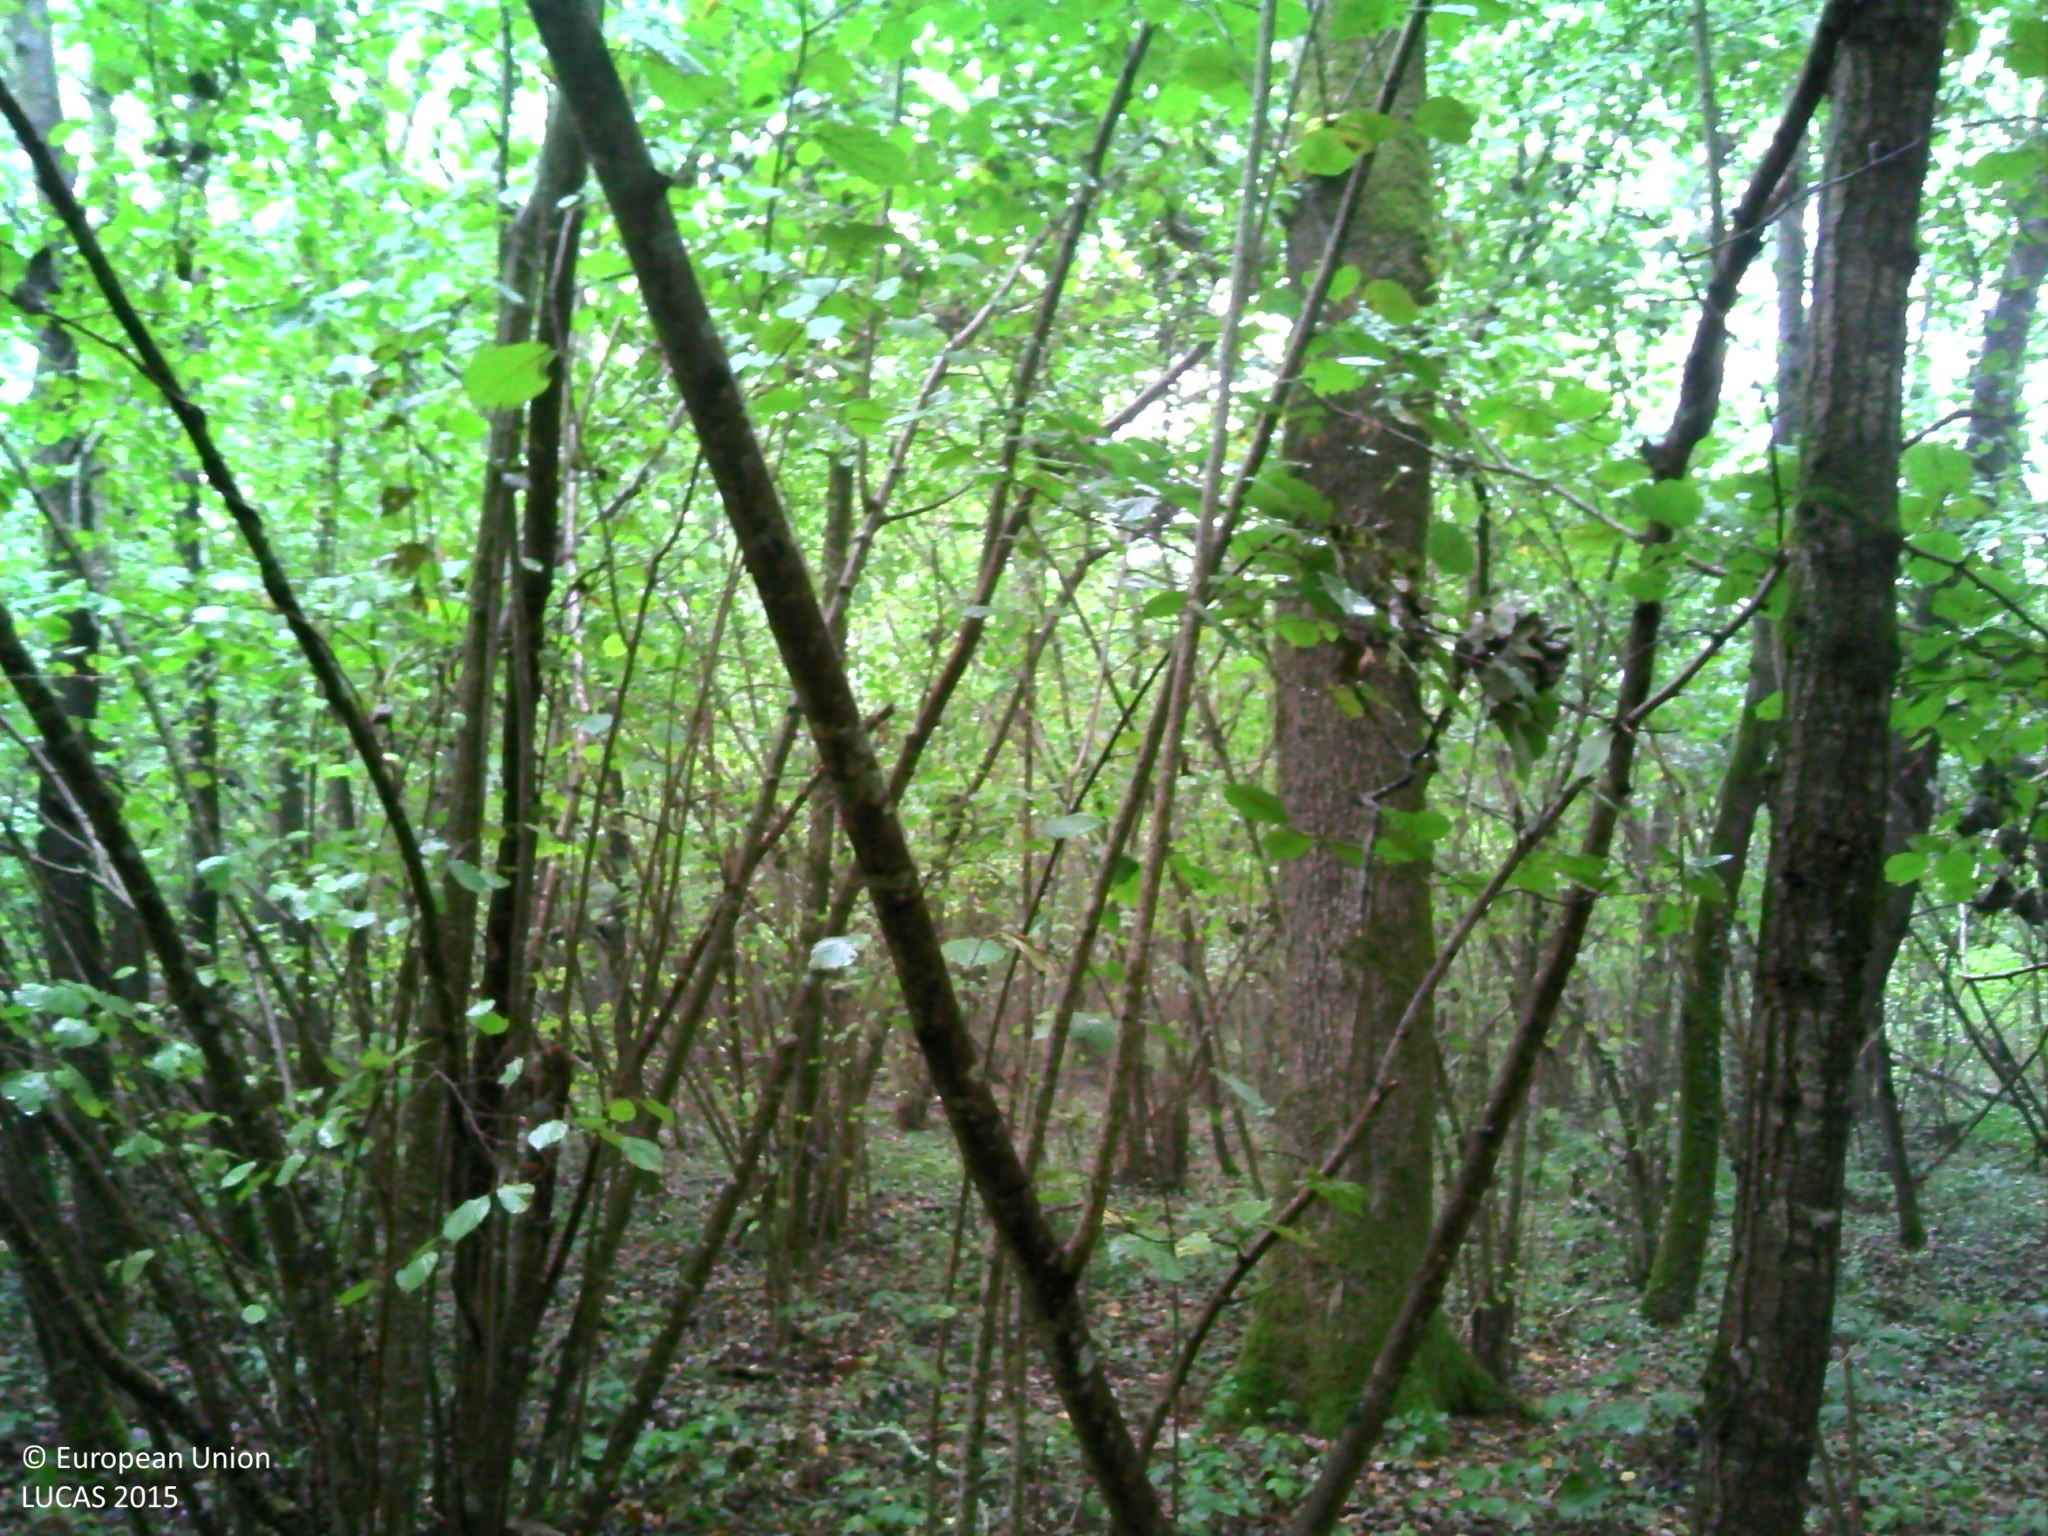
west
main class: Woodland
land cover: Broadleaved woodland
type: mesophytic deciduous forest
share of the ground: > 75 %
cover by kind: broadleaved forest trees 90 %, herbaceous plants 5 %, lichens and mosses 5 %
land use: Forestry
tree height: > 5 m
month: October
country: FR
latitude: 46.4204
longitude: 5.1232
